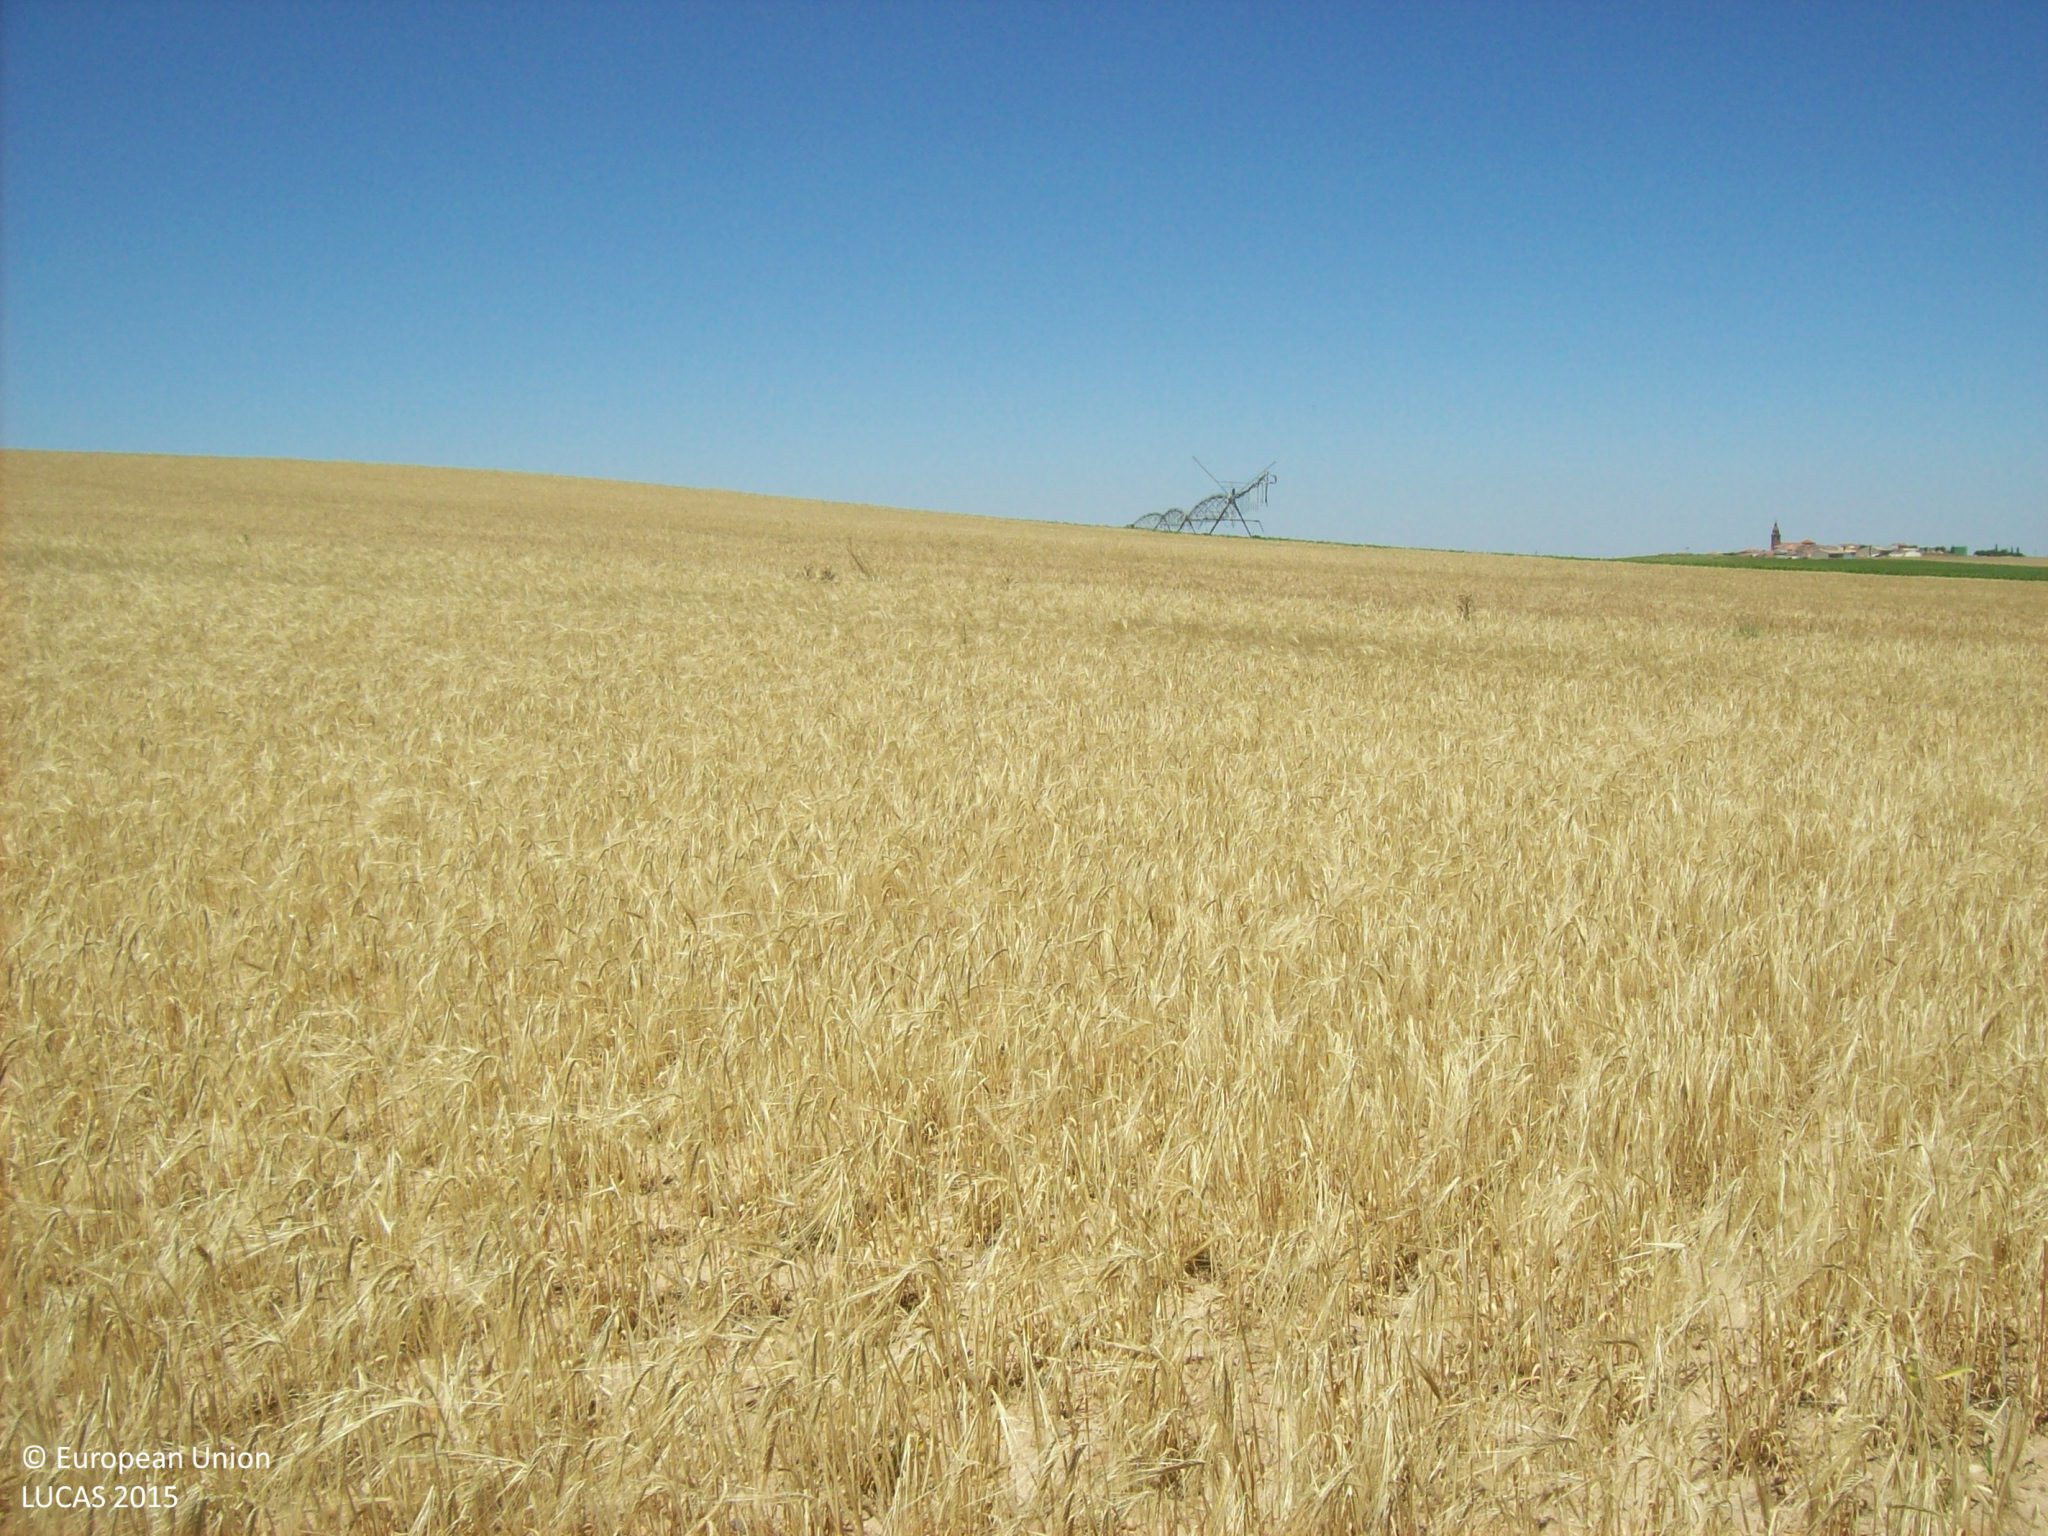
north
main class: Cropland
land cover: Barley
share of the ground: > 75 %
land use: Agriculture (excluding fallow land and kitchen gardens)
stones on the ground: < 10 %
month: June
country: ES
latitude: 41.2011
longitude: -5.2287
